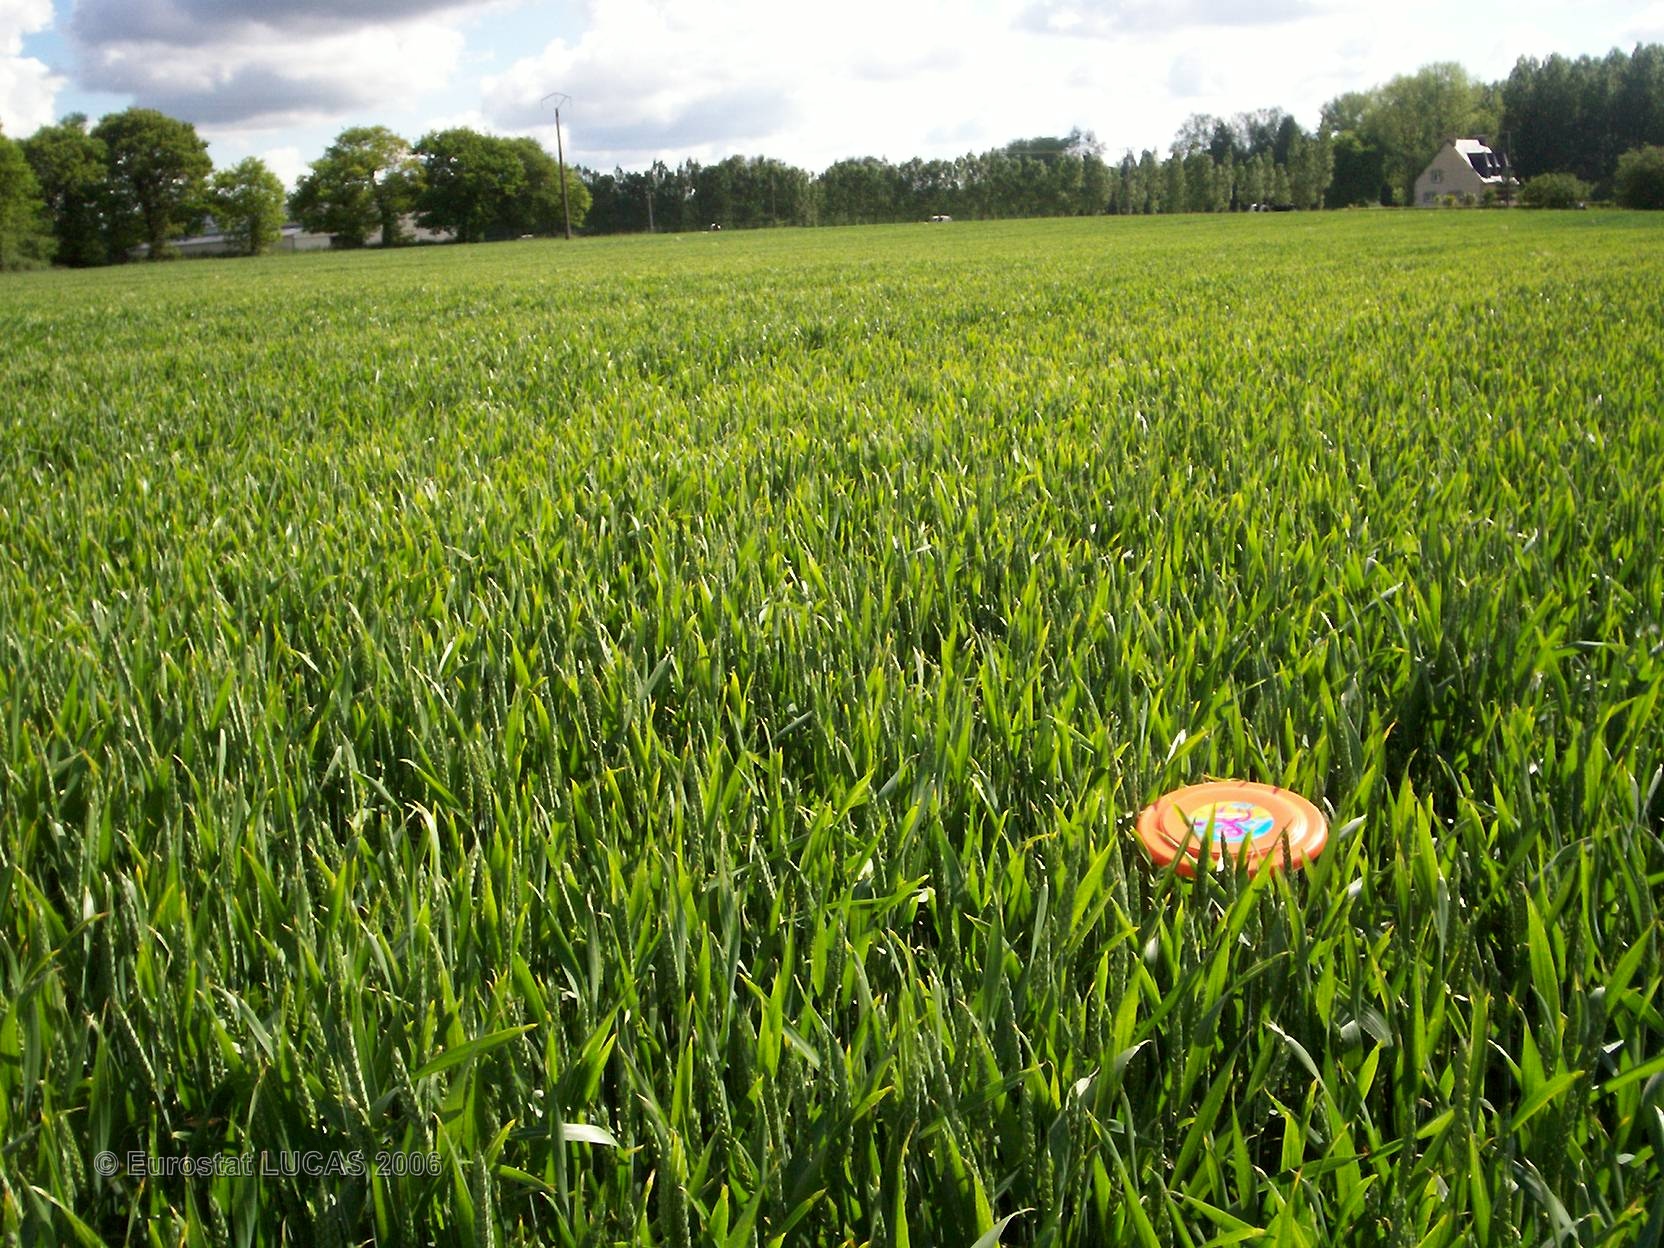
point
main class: Cropland
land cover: Common wheat
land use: Agriculture (excluding fallow land and kitchen gardens)
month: May
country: FR
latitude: 48.5602
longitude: -3.0104
